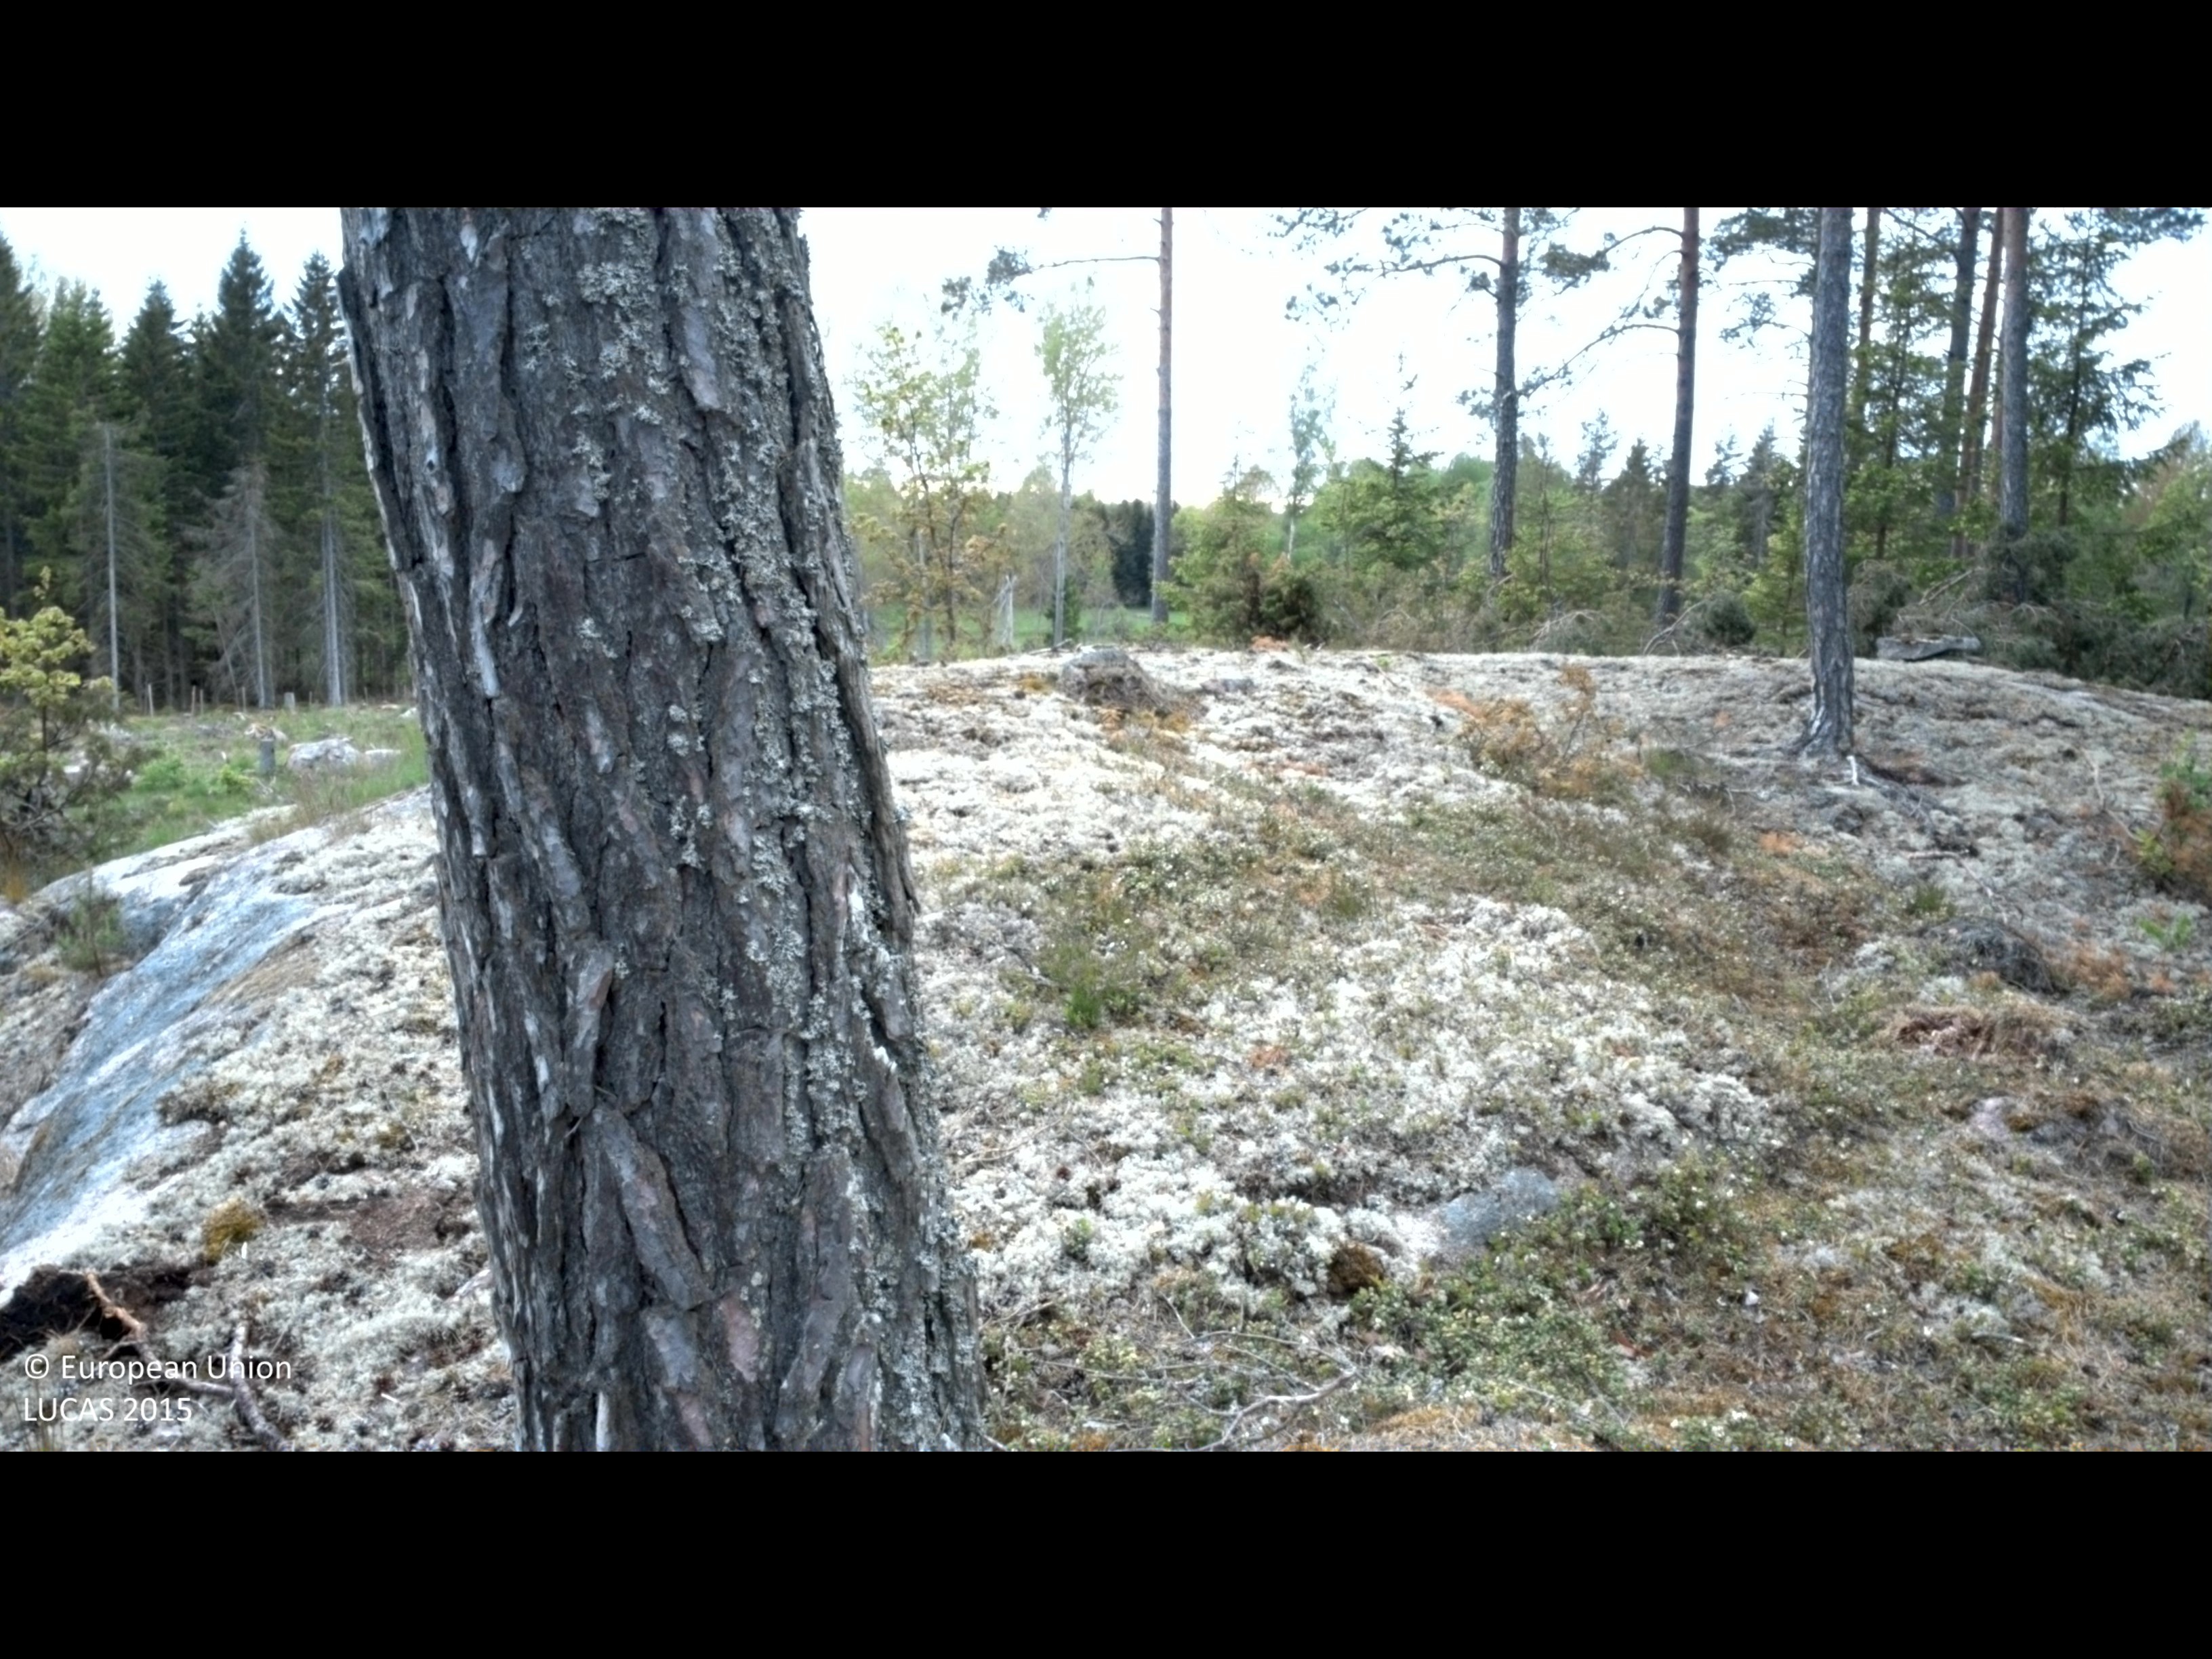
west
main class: Woodland
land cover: Pine dominated coniferous woodland
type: boreal forest
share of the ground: 10 - 25 %
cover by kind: lichens and mosses 45 %, shrubs 35 %, coniferous forest trees 15 %, broadleaved forest trees 5 %
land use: Forestry
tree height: > 5 m
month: May
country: SE
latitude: 57.4801
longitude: 16.2194
